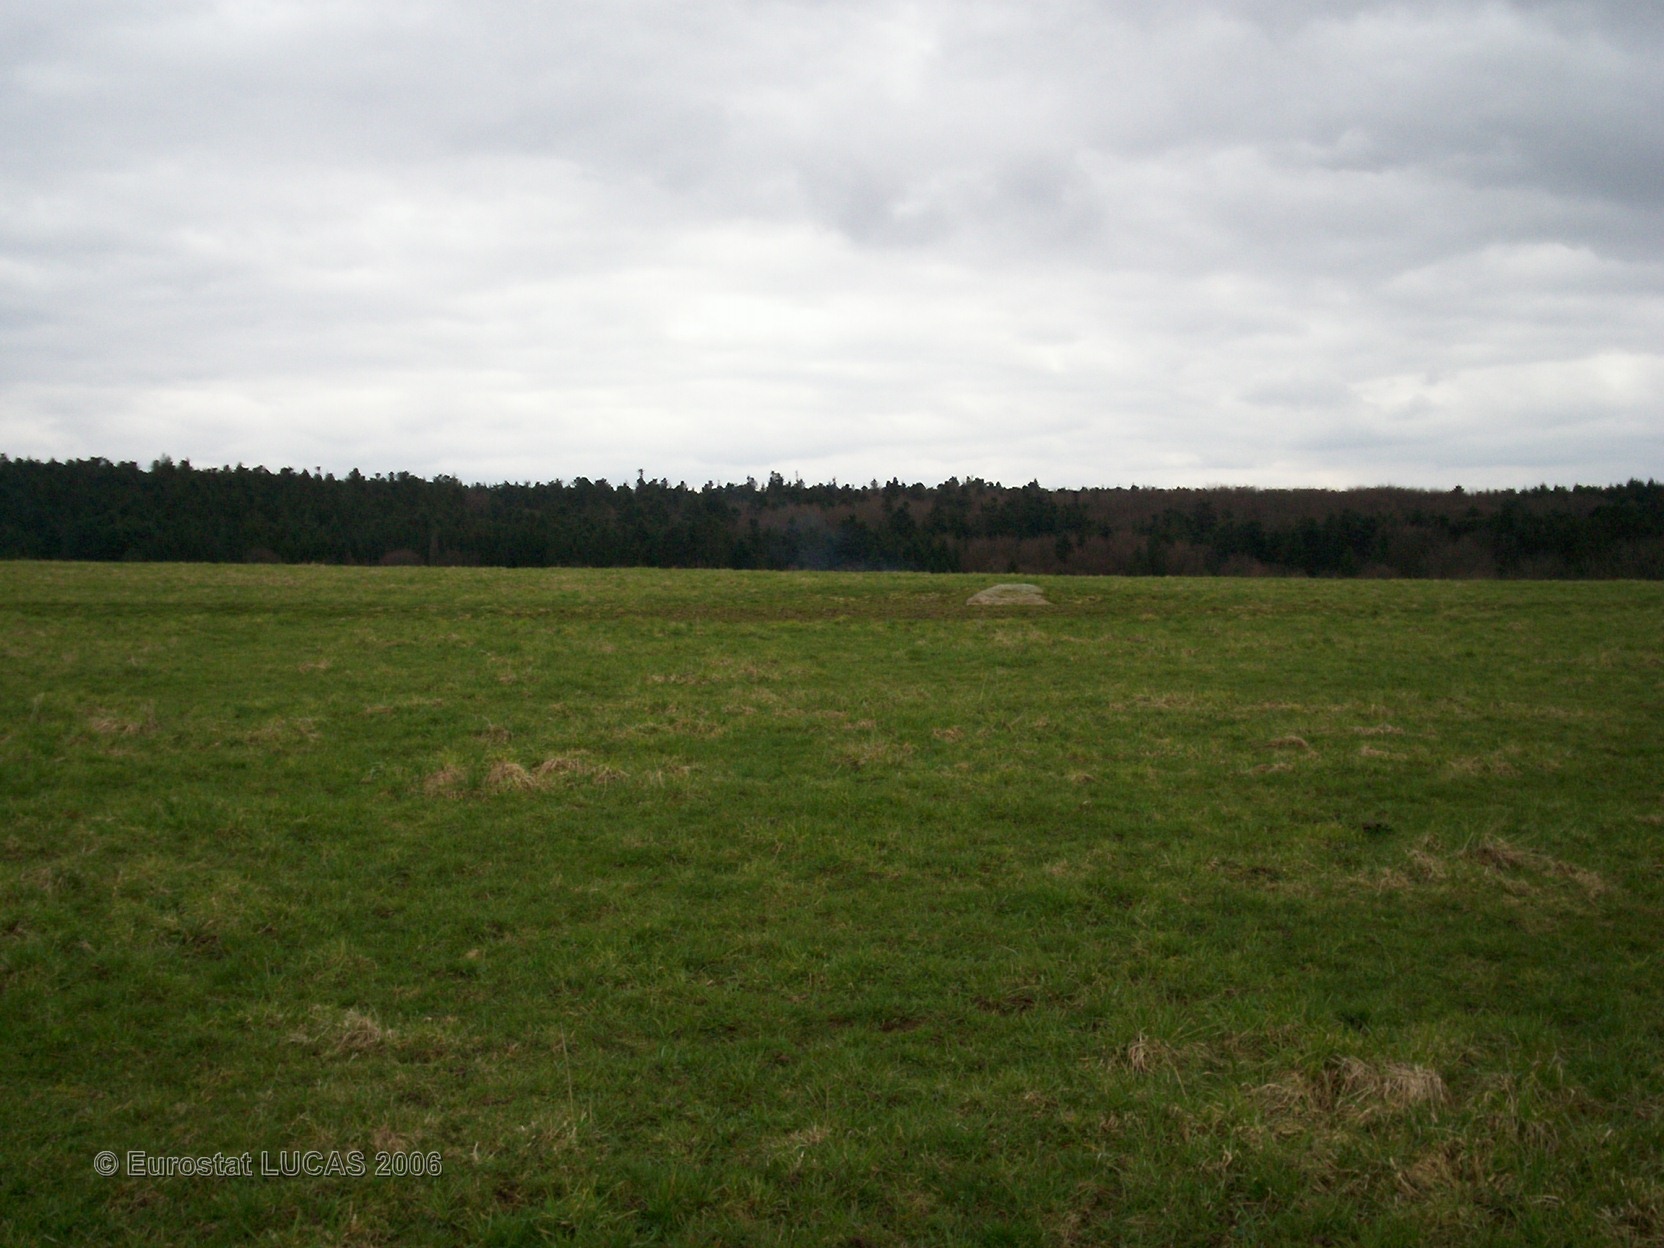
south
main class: Grassland
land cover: Grassland without tree/shrub cover
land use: Agriculture (excluding fallow land and kitchen gardens)
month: April
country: FR
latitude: 48.0060
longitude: 6.5025
